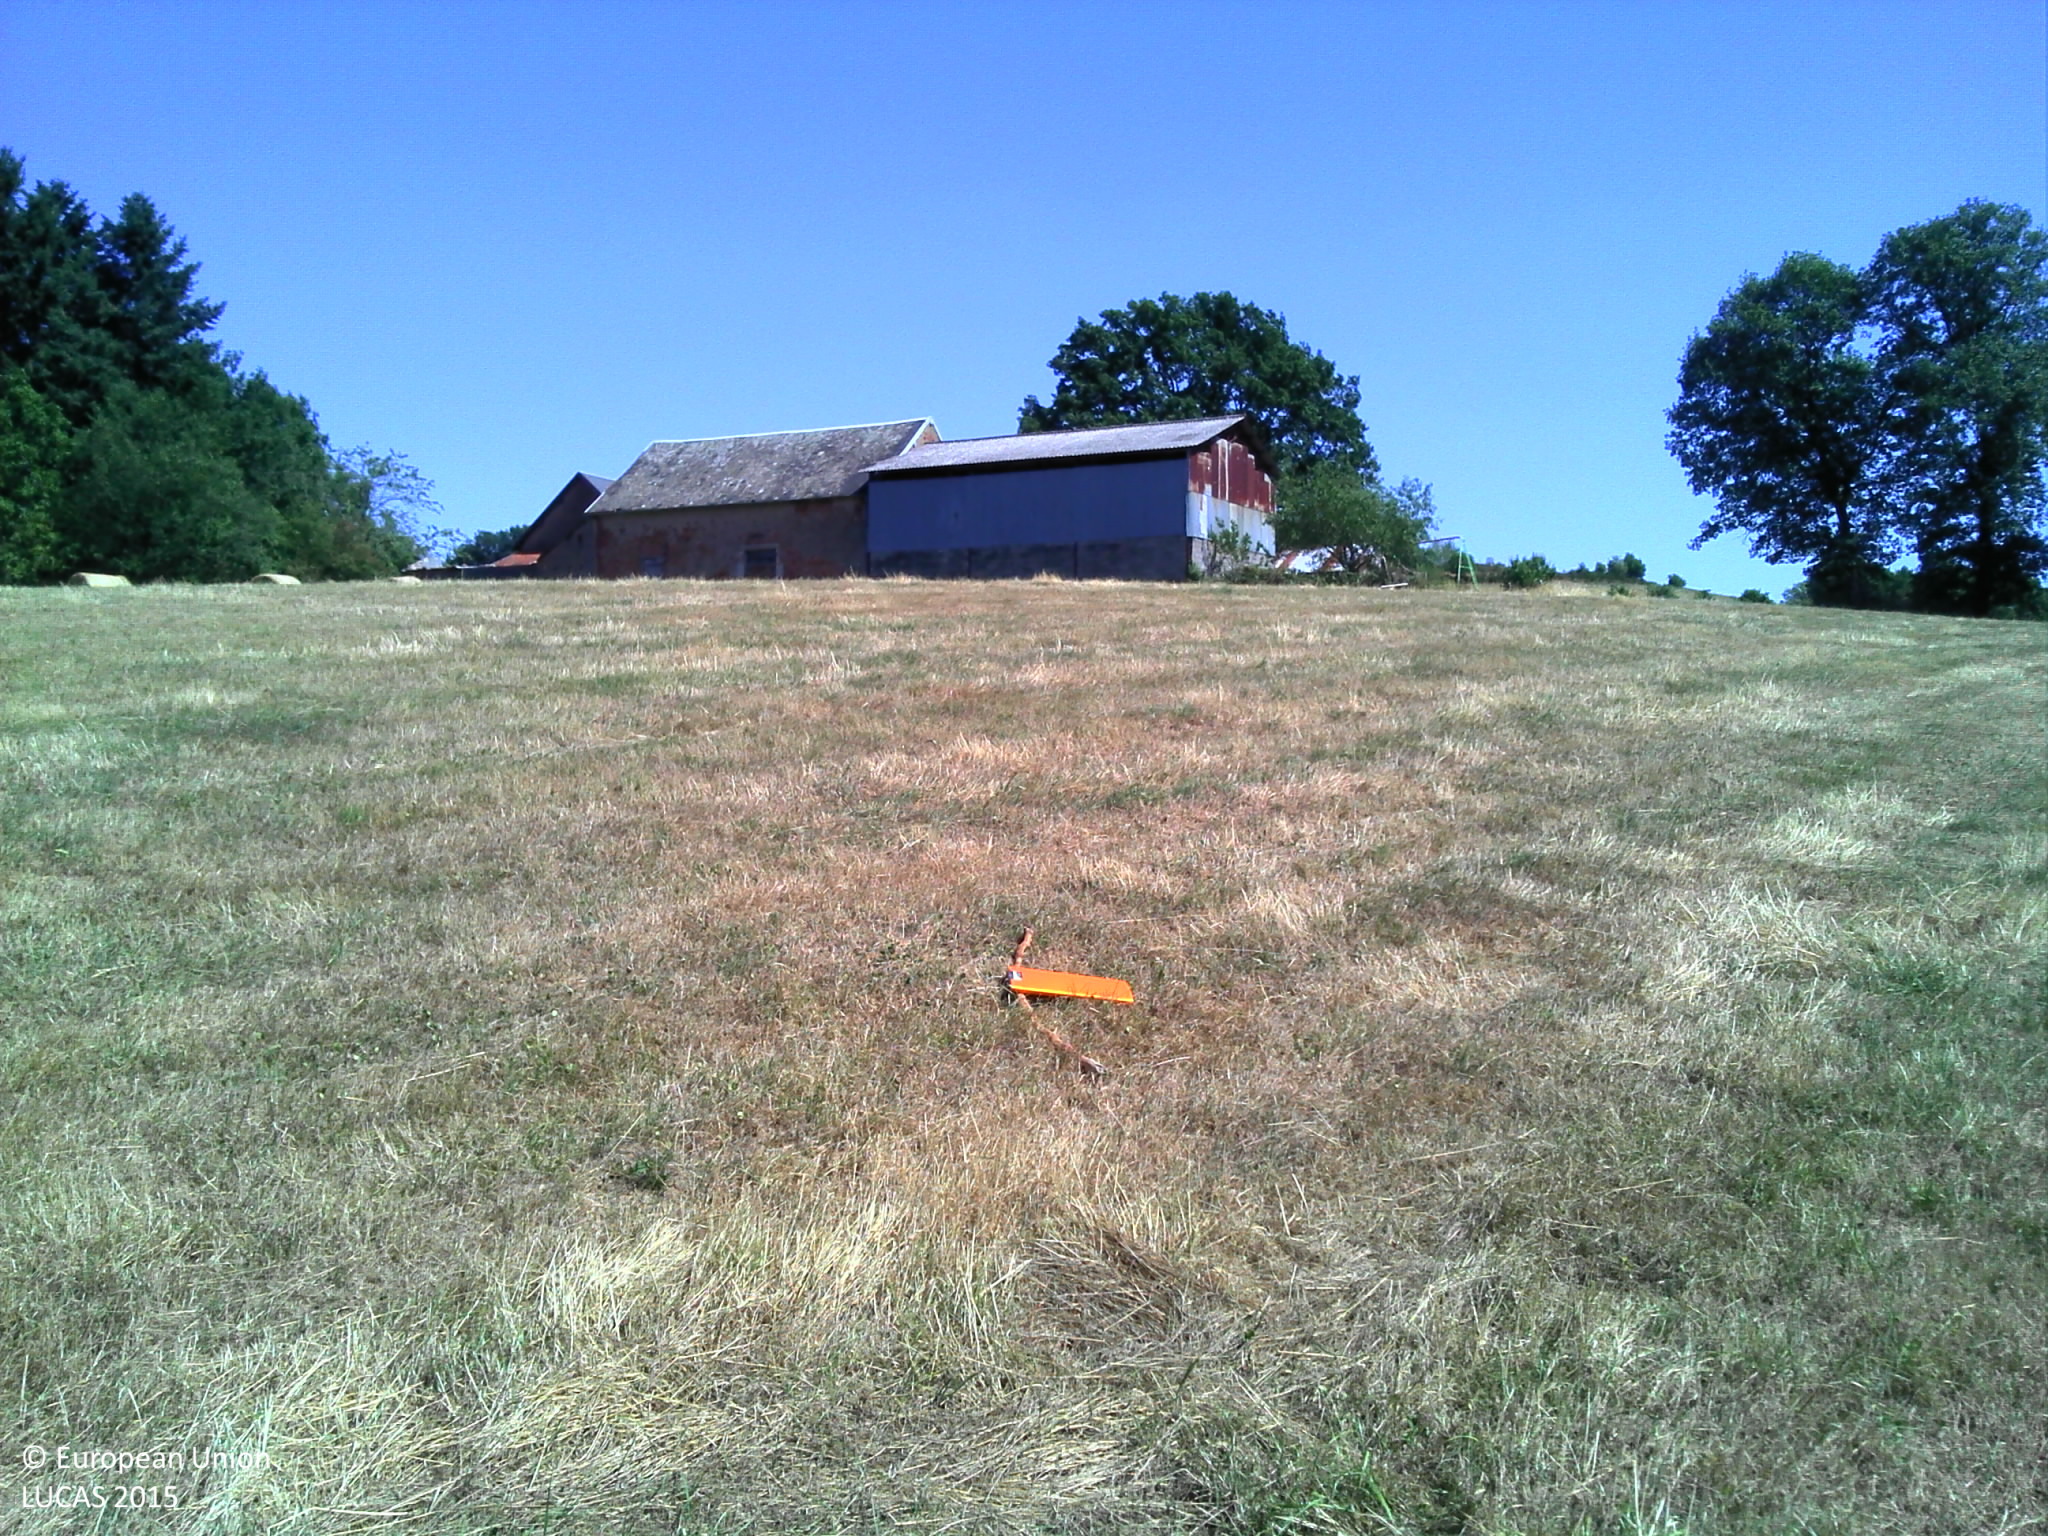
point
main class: Grassland
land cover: Grassland without tree/shrub cover
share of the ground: > 75 %
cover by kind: herbaceous plants 100 %
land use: Agriculture (excluding fallow land and kitchen gardens)
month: August
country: FR
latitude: 46.1441
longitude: 3.6438
